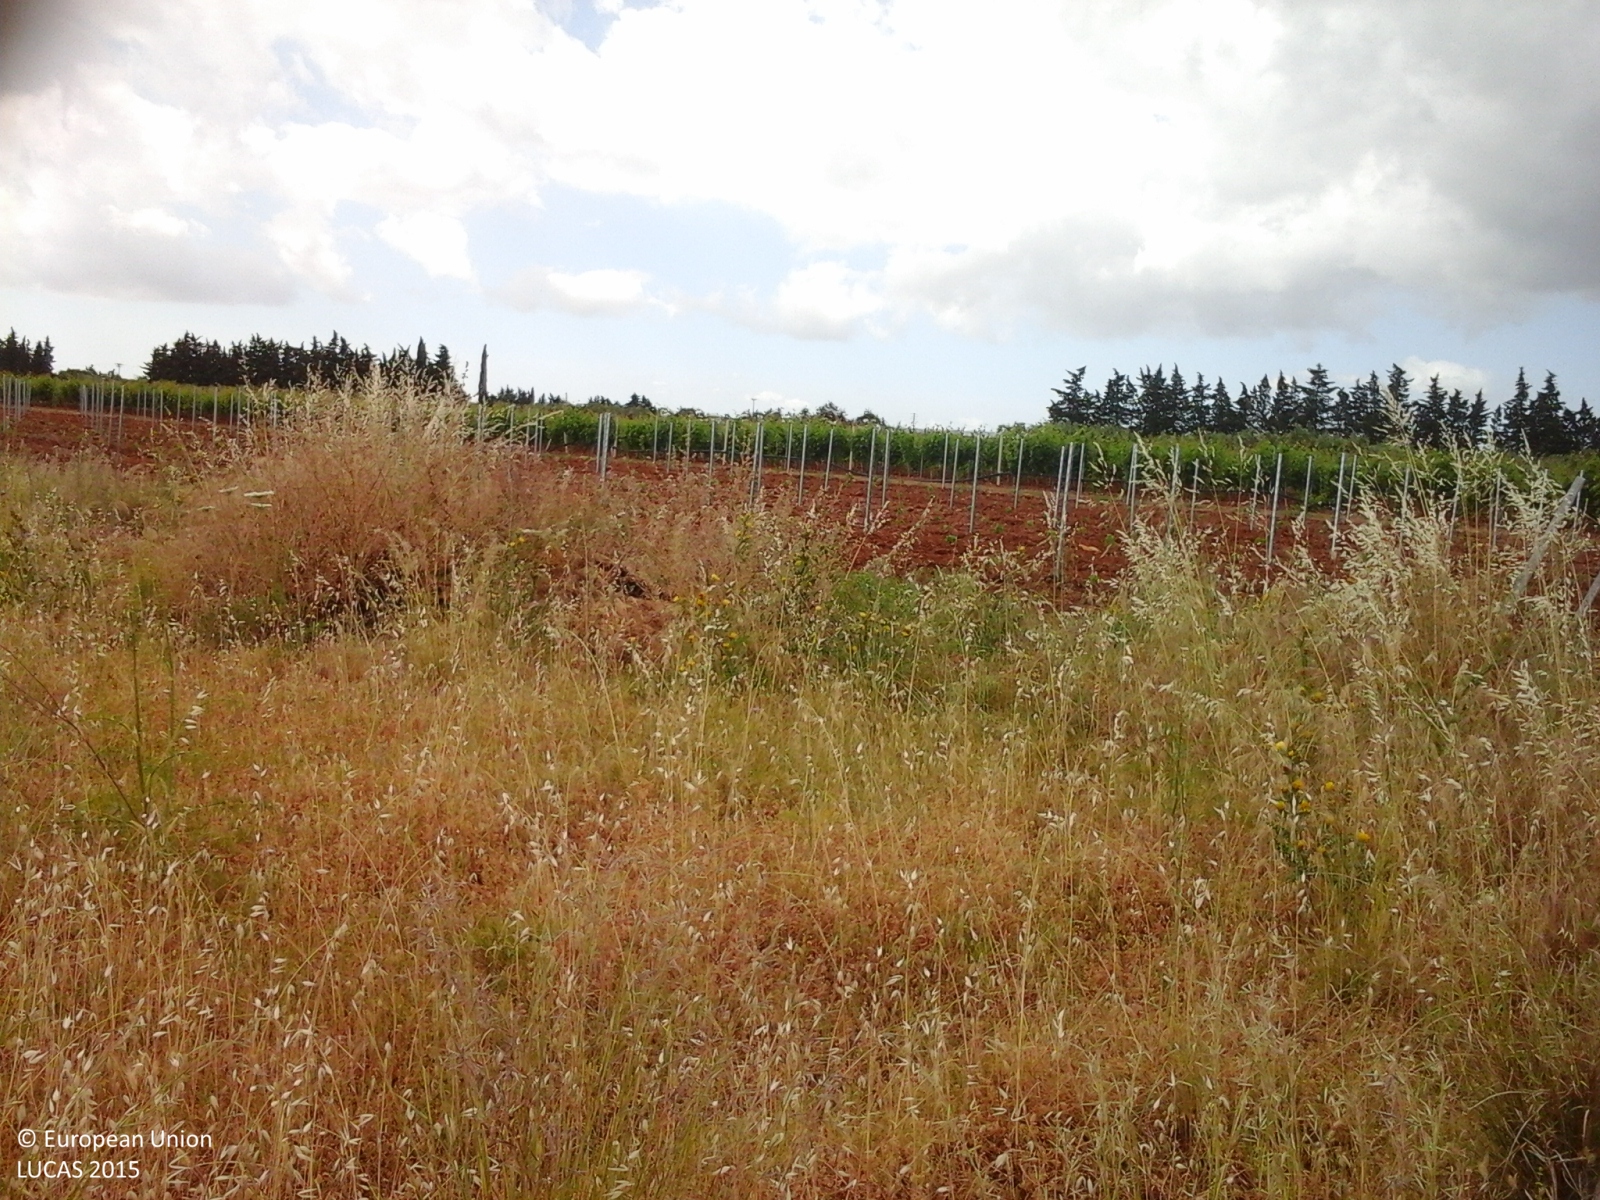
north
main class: Grassland
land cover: Spontaneously vegetated surfaces
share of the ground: > 75 %
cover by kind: herbaceous plants 90 %, consolidated bare surface 10 %
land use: Agriculture (excluding fallow land and kitchen gardens)
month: May
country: IT
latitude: 37.6121
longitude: 12.9119
